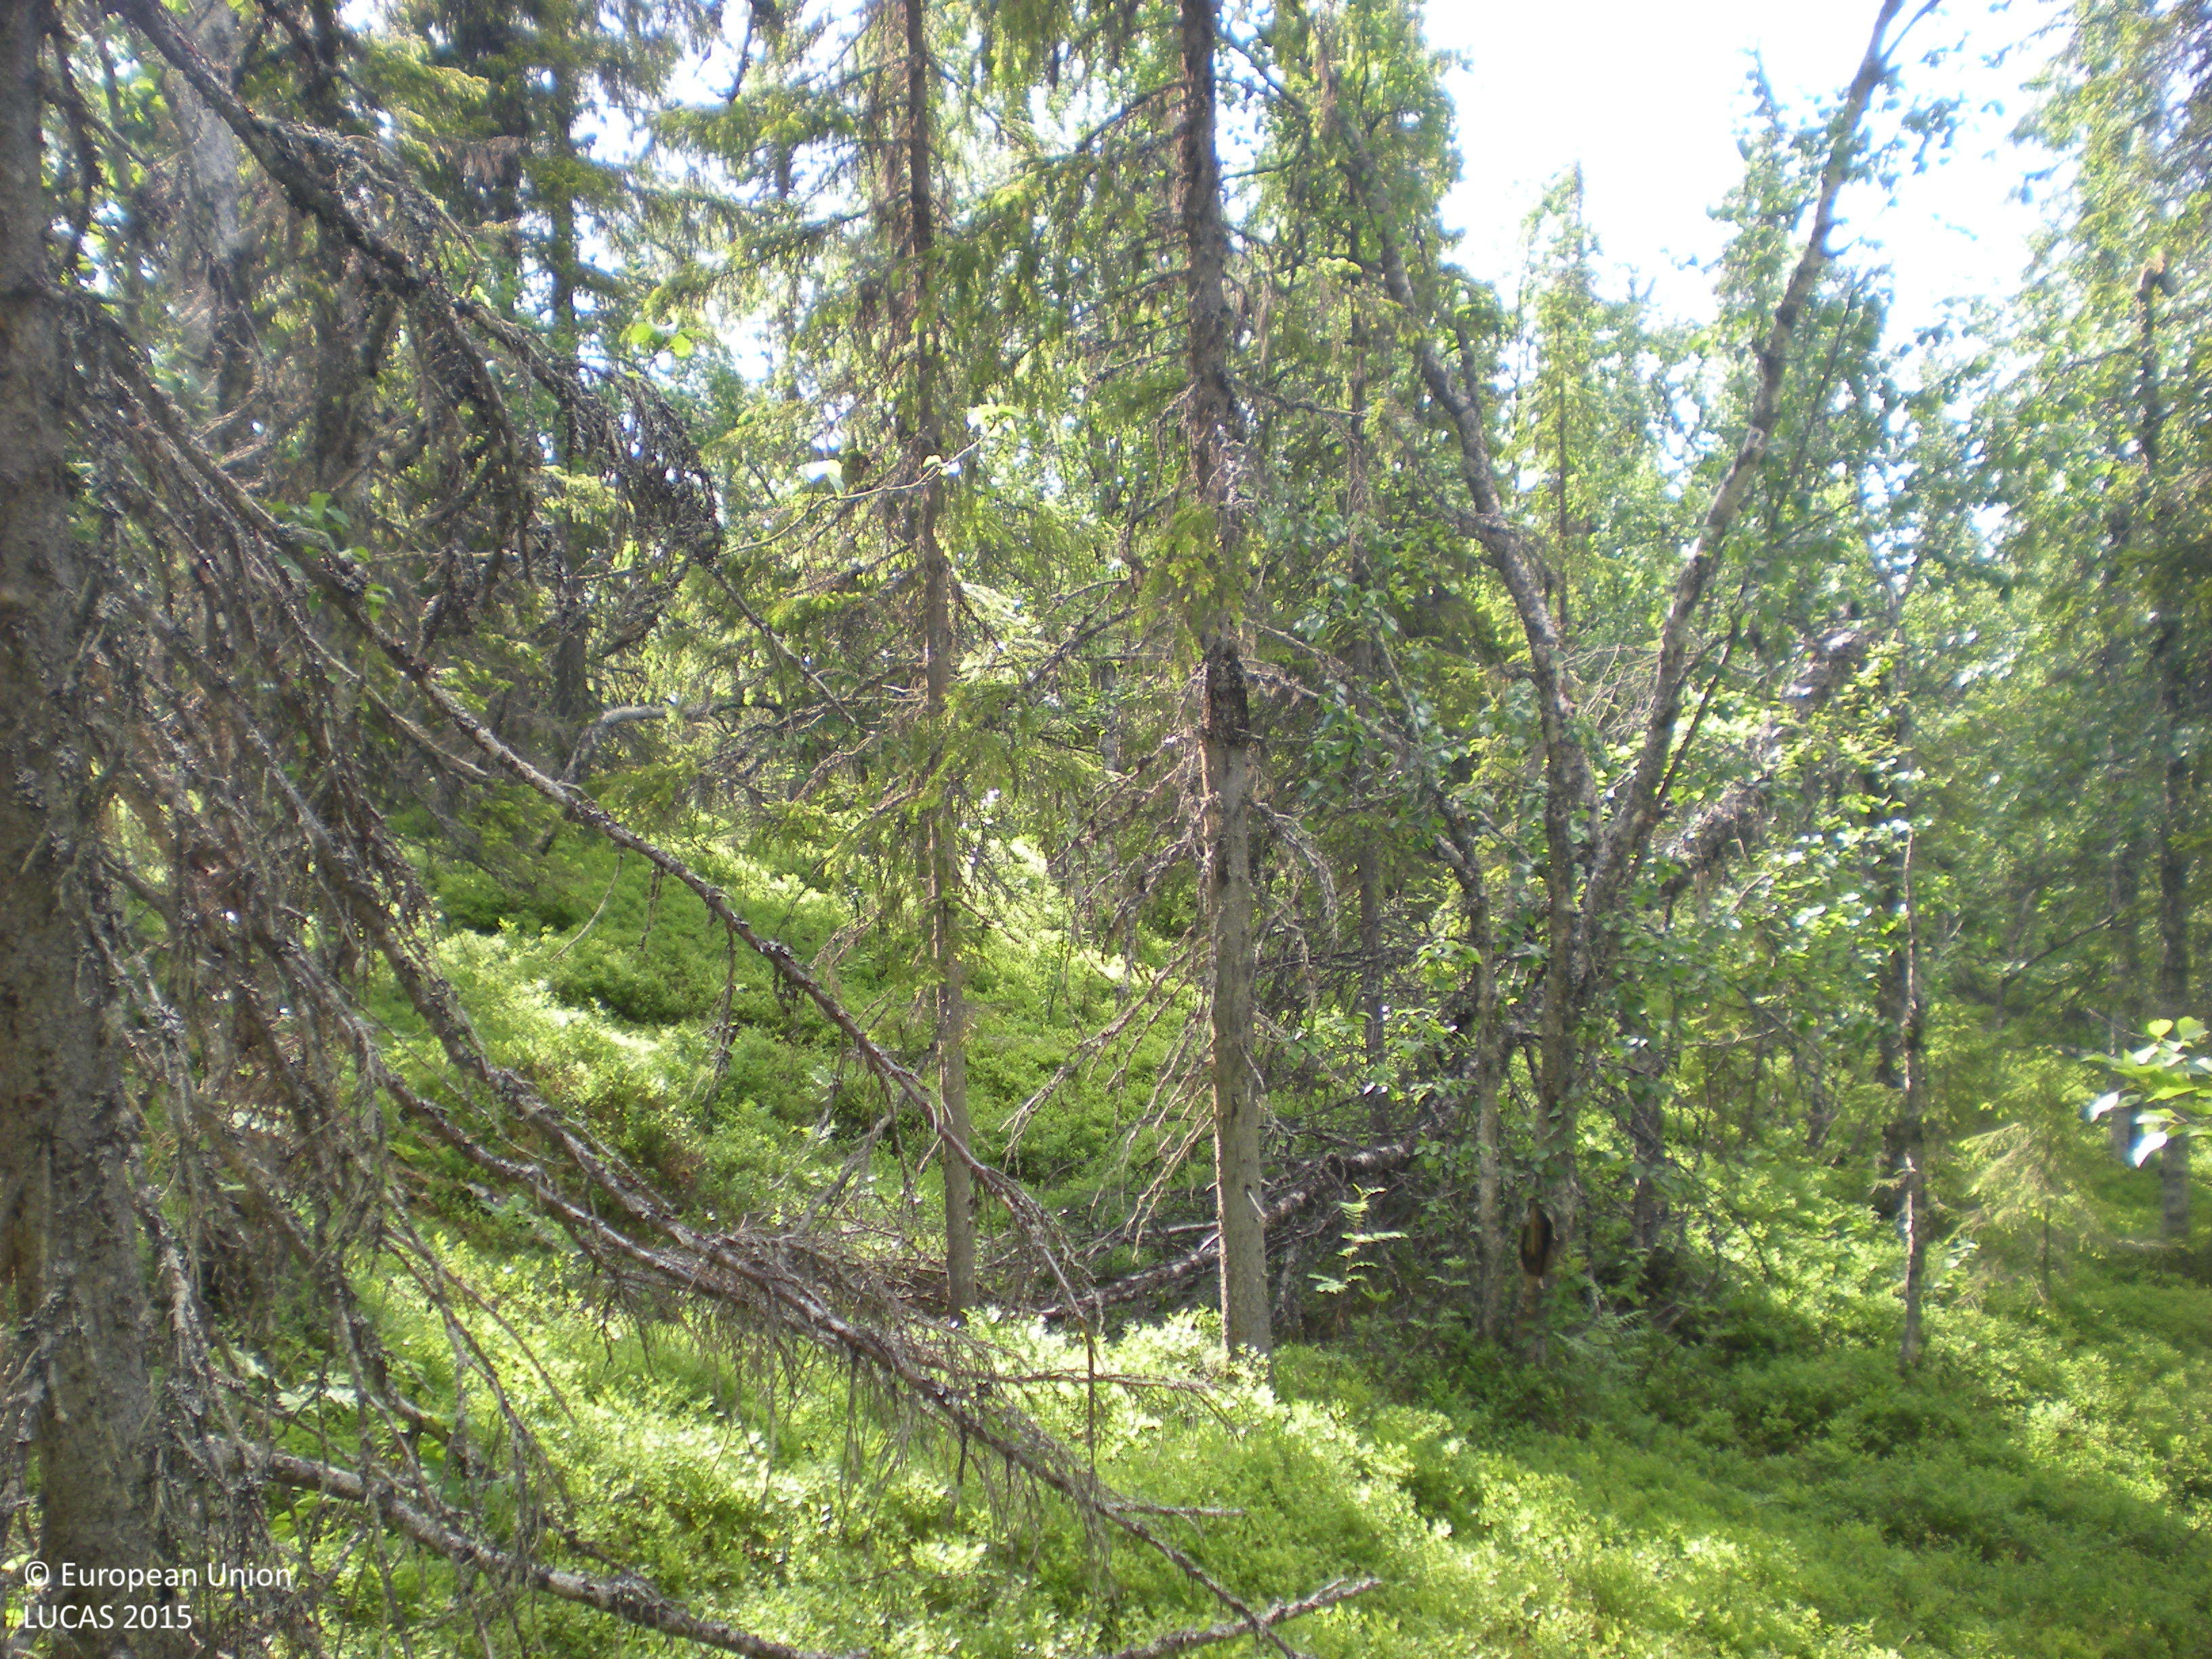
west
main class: Woodland
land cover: Spruce dominated mixed woodland
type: boreal forest
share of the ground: 50 - 75 %
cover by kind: coniferous forest trees 35 %, broadleaved forest trees 30 %, shrubs 25 %, lichens and mosses 10 %
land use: Forestry
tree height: > 5 m
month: July
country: SE
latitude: 65.5558
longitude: 16.8690
